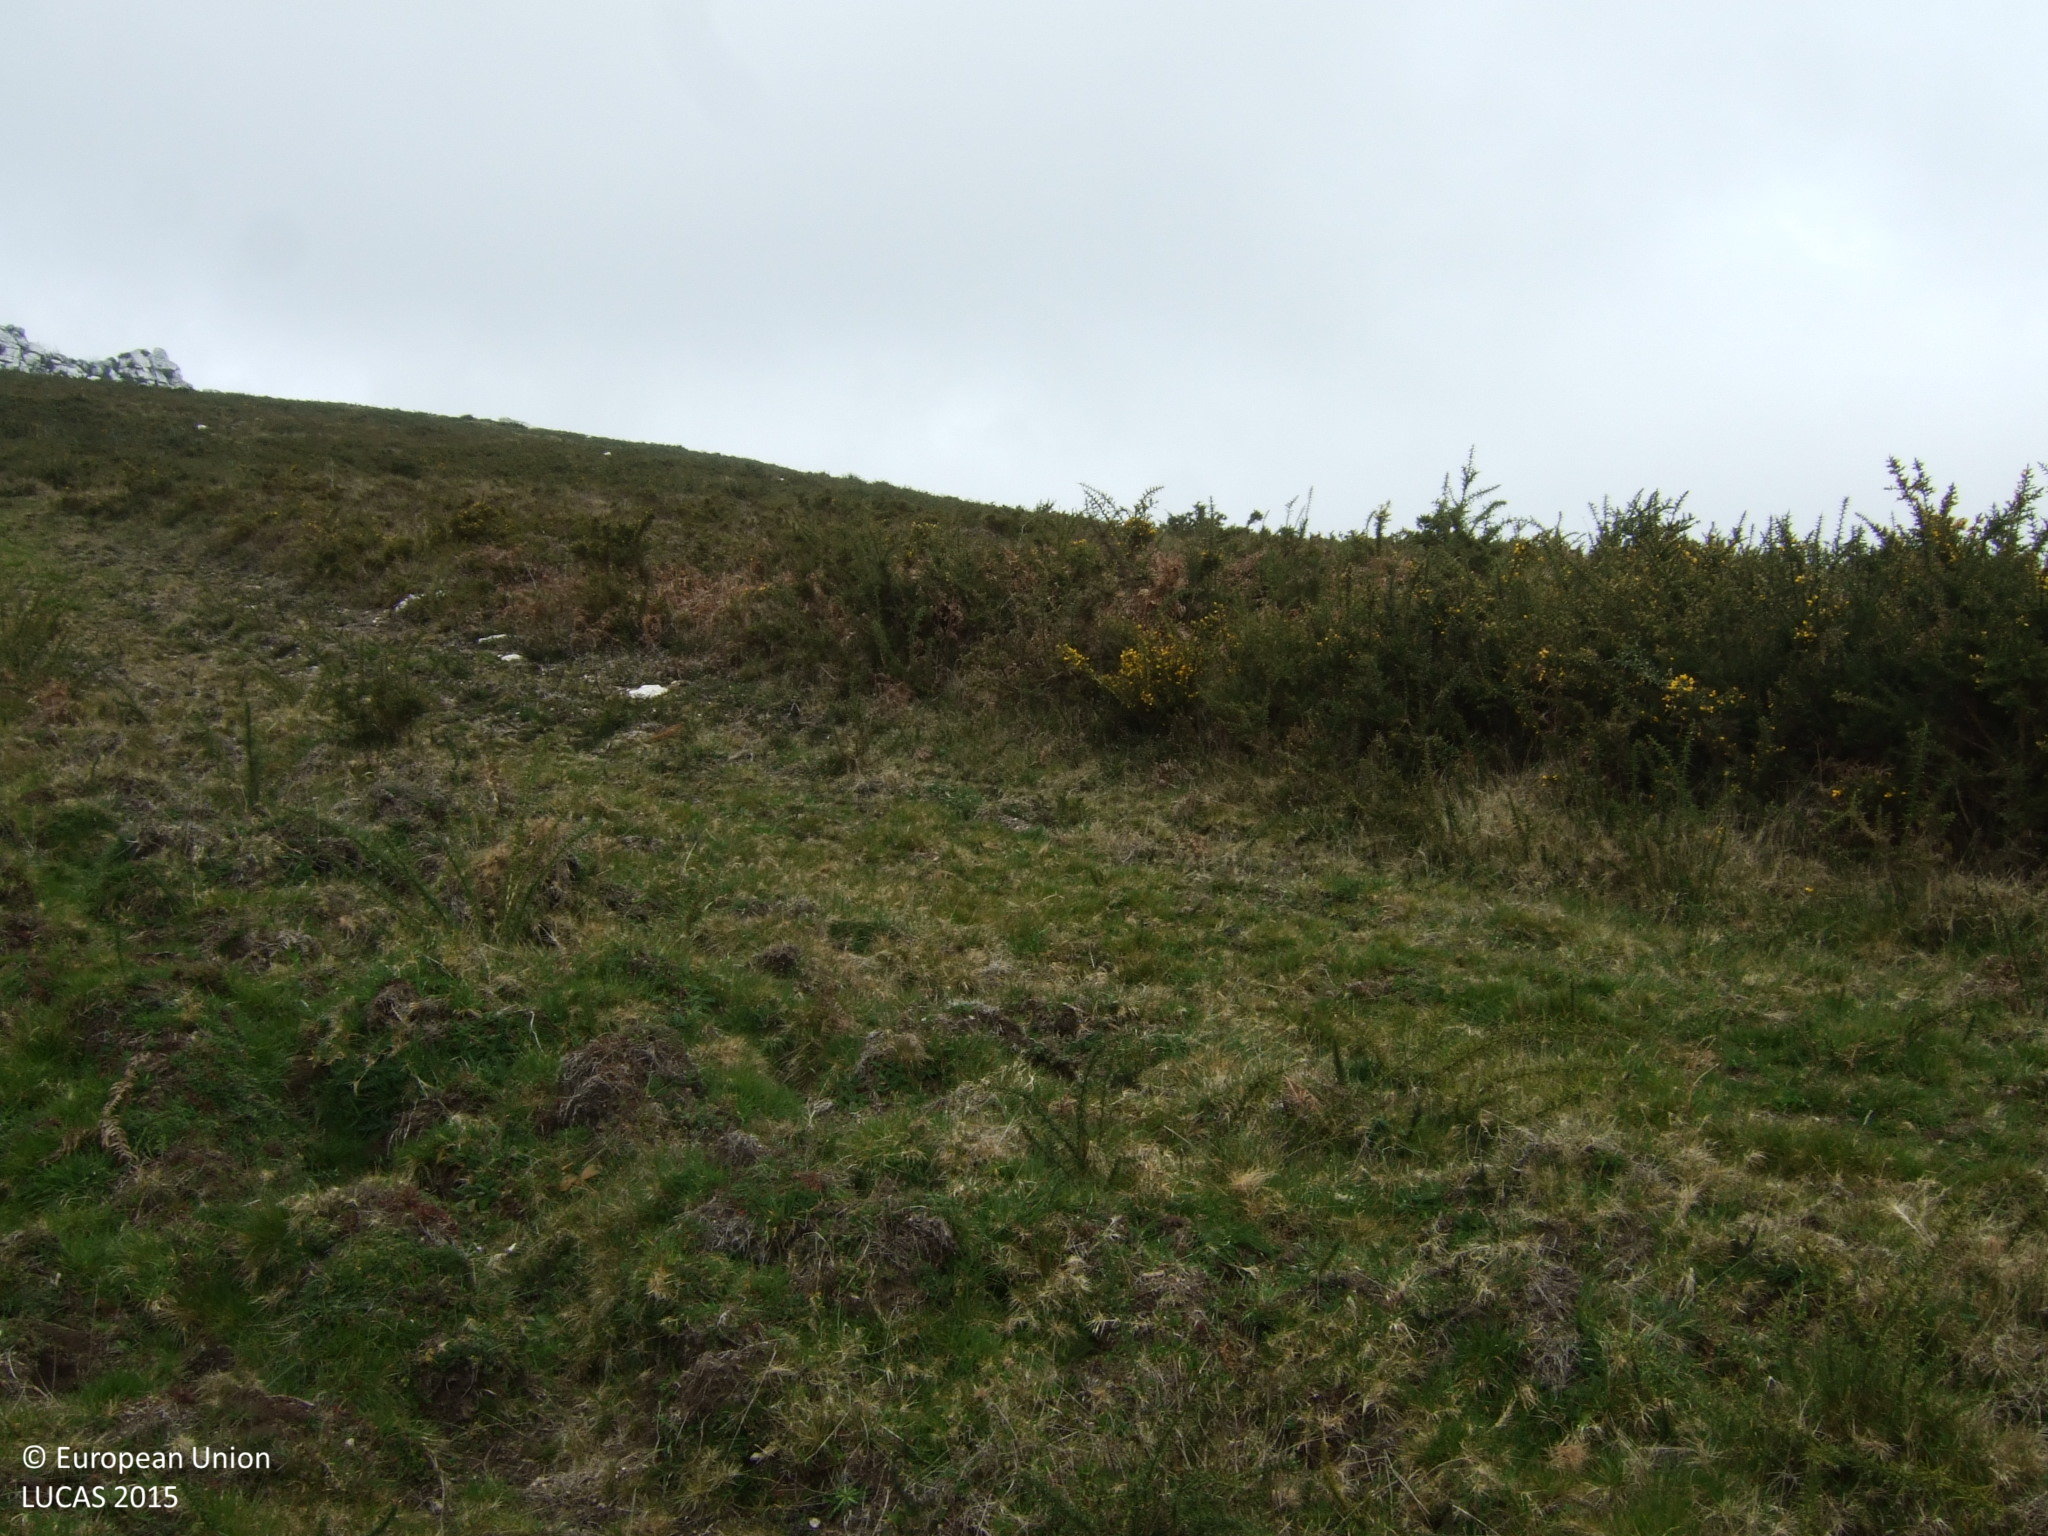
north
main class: Shrubland
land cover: Shrubland without tree cover
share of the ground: > 75 %
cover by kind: shrubs 100 %
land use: Abandoned areas
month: March
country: ES
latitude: 42.9455
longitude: -7.8938
